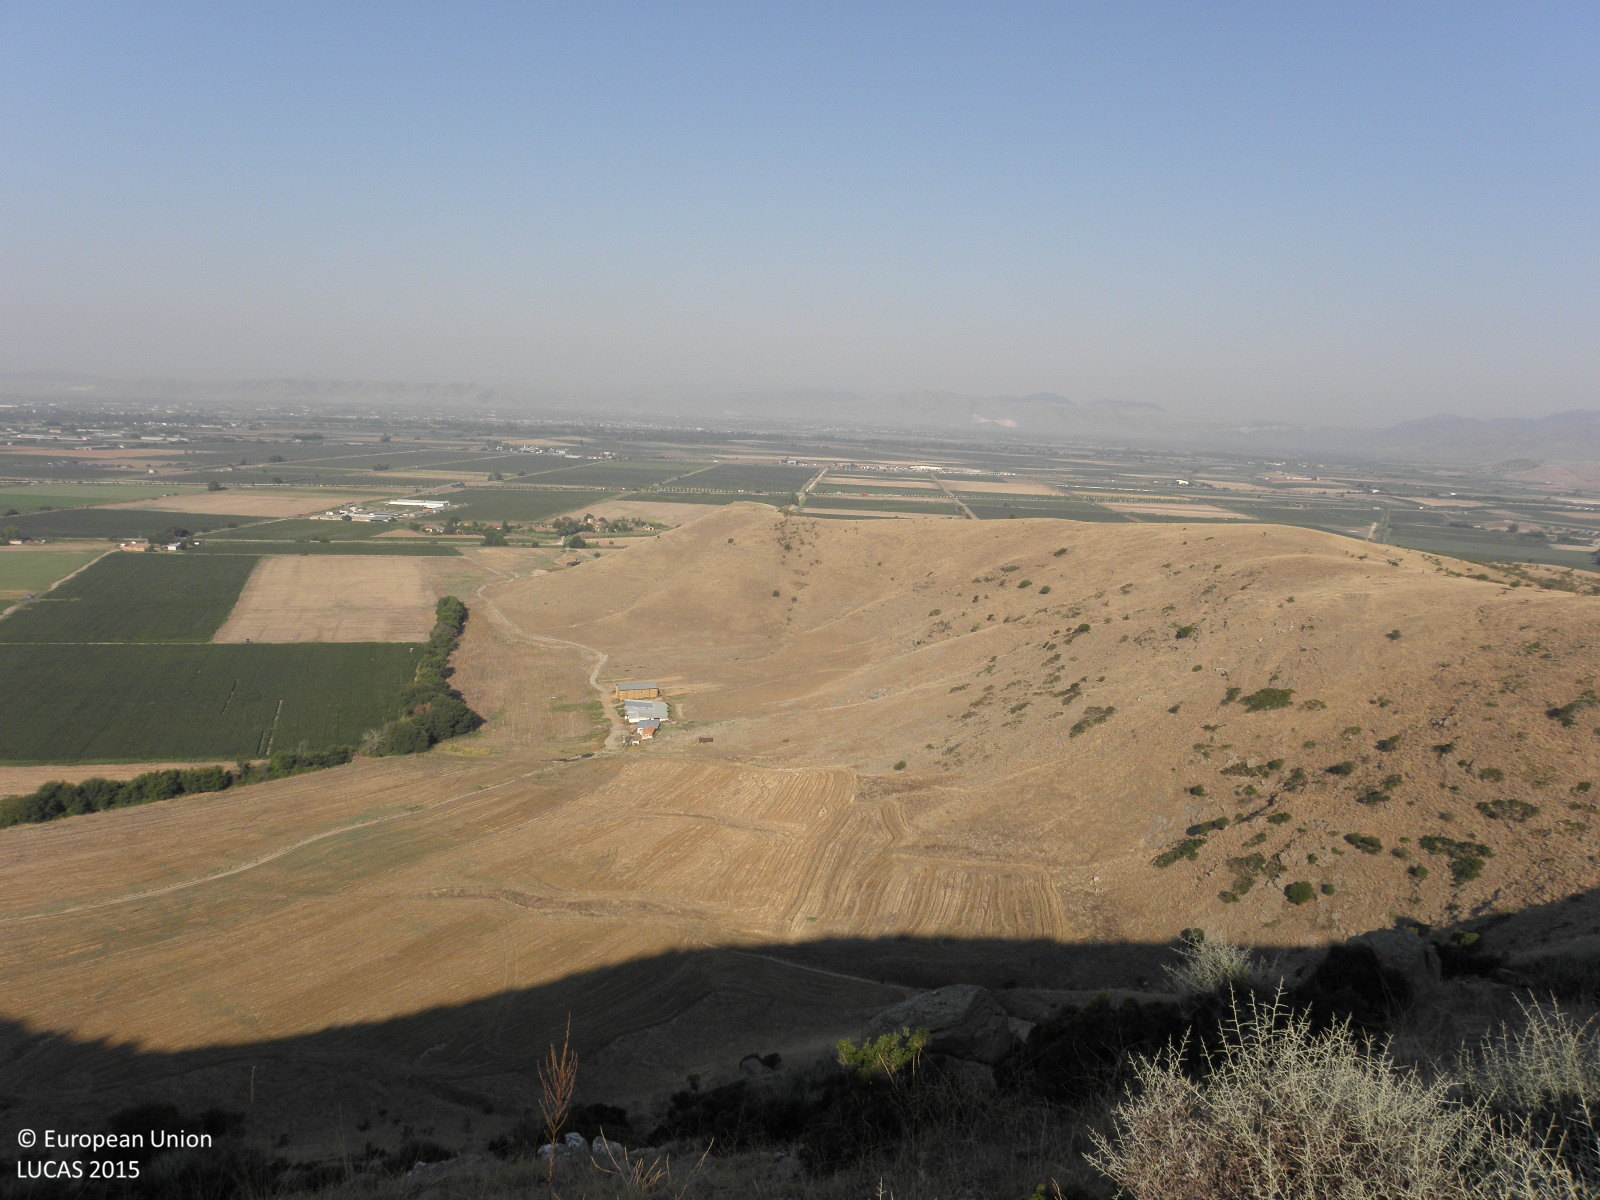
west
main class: Shrubland
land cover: Shrubland without tree cover
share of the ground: 25 - 50 %
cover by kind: shrubs 40 %, herbaceous plants 30 %, consolidated bare surface 30 %
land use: Semi-natural and natural areas not in use
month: September
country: GR
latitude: 39.7194
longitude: 22.5089
